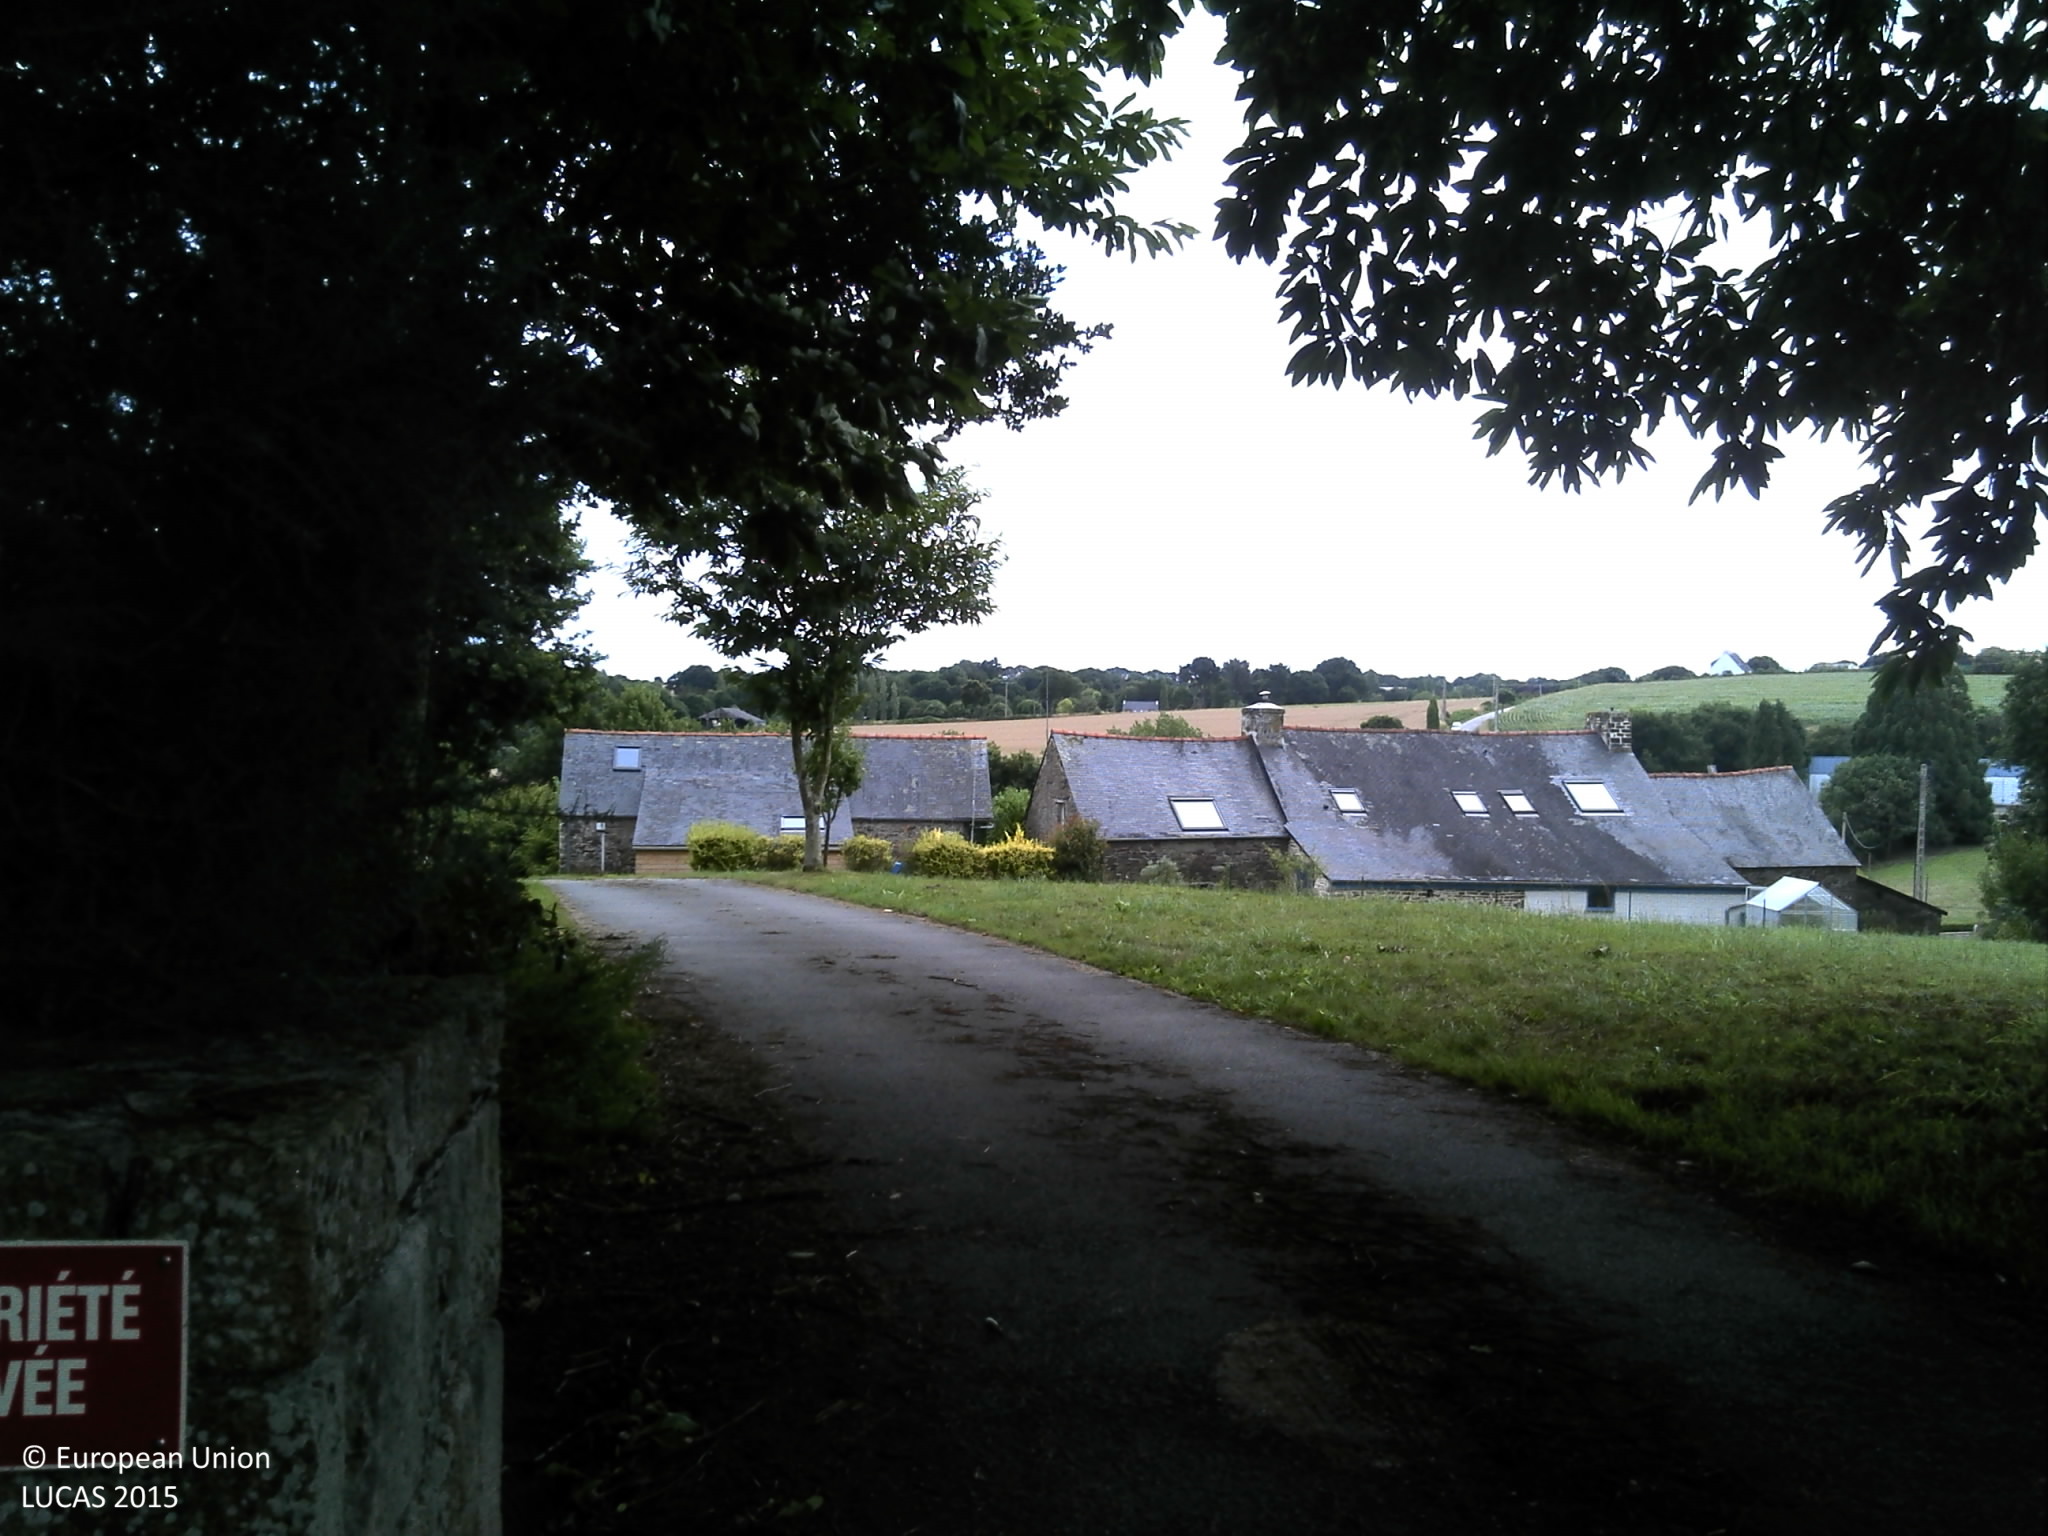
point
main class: Grassland
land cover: Grassland without tree/shrub cover
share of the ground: > 75 %
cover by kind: herbaceous plants 100 %
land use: Residential
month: July
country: FR
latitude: 48.2707
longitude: -3.5932
